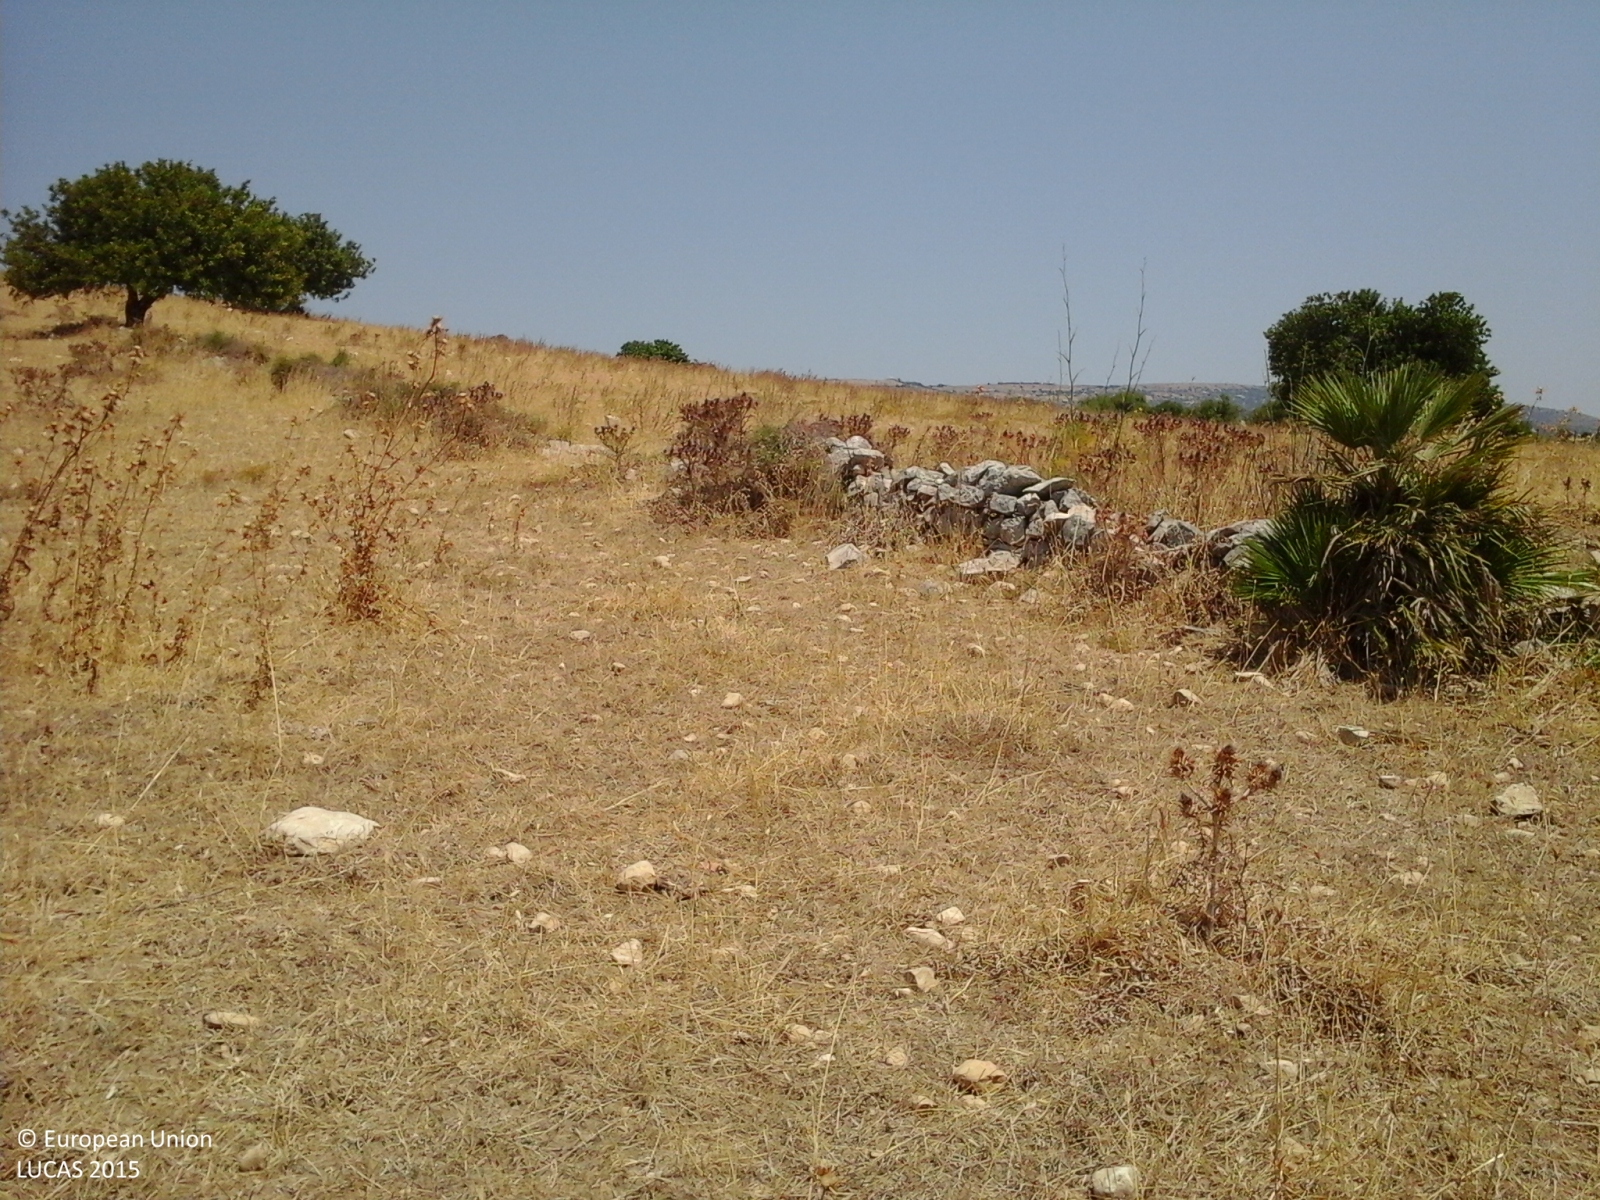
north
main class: Grassland
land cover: Spontaneously vegetated surfaces
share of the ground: > 75 %
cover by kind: herbaceous plants 100 %
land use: Agriculture (excluding fallow land and kitchen gardens)
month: July
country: IT
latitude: 36.8159
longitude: 14.6371
